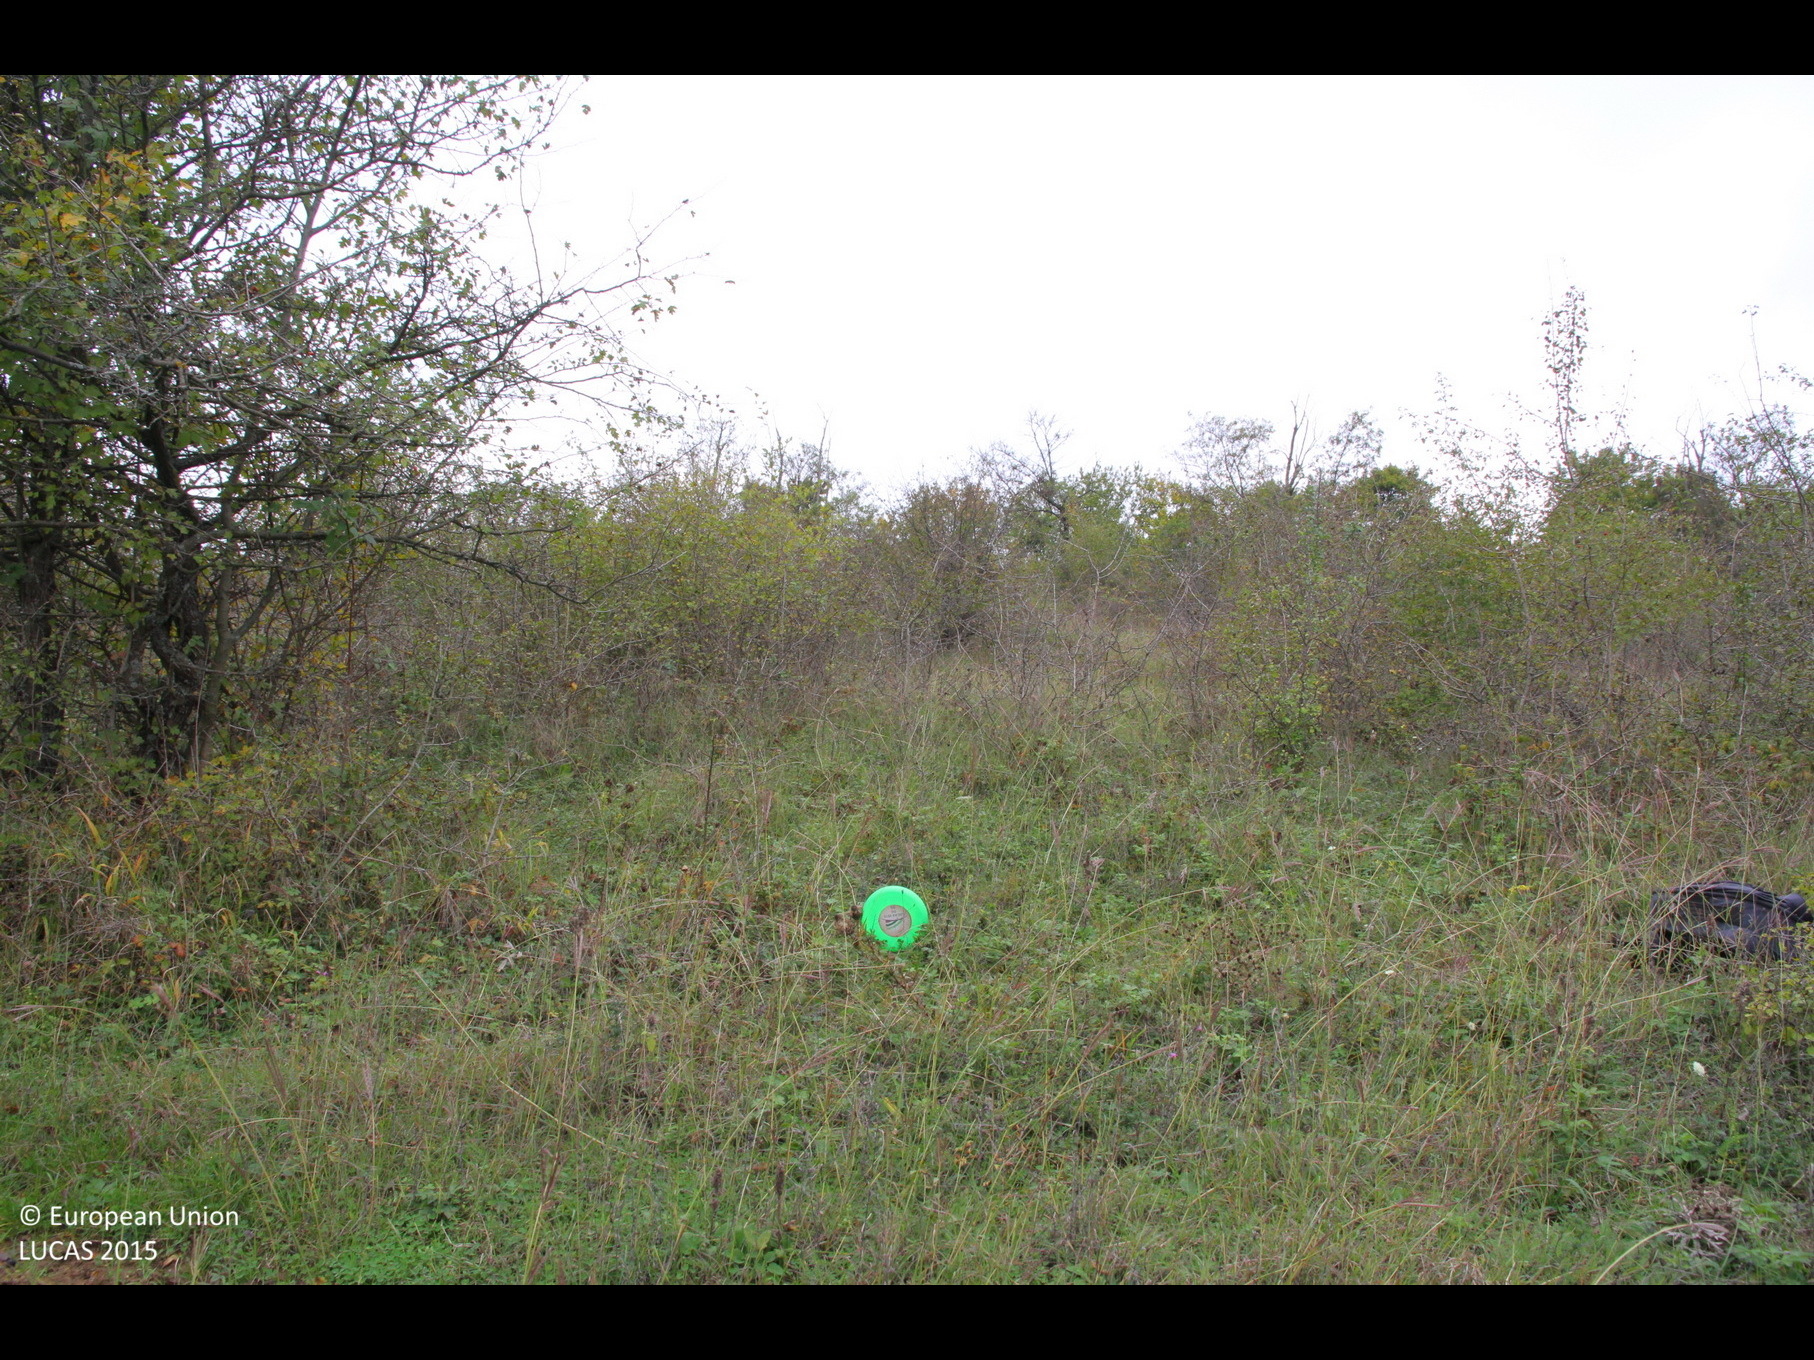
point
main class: Grassland
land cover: Grassland with sparse tree/shrub cover
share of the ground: > 75 %
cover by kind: herbaceous plants 85 %, shrubs 10 %, broadleaved forest trees 5 %
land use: Agriculture (excluding fallow land and kitchen gardens)
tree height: < 5 m
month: October
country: BG
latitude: 43.5068
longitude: 27.1027
